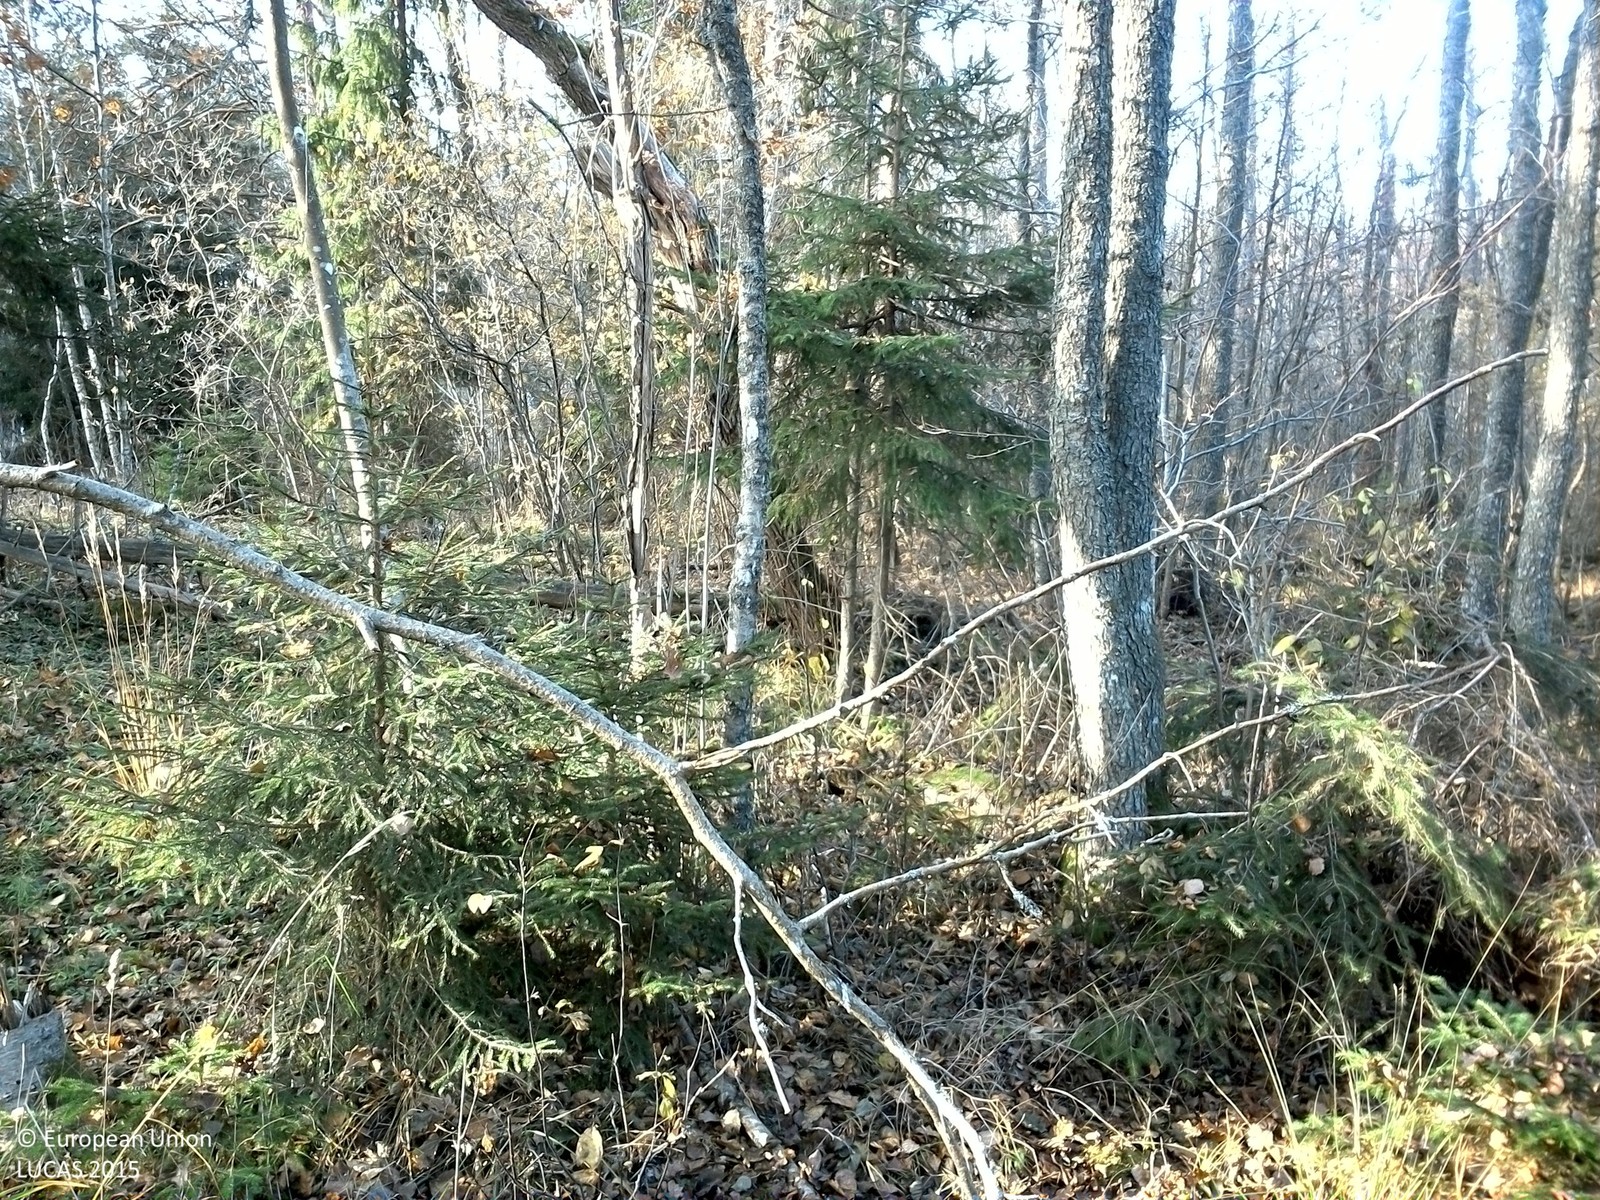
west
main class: Woodland
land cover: Broadleaved woodland
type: hemiboreal forest and nemoral coniferous forest and mixed broadleaved-coniferous forest
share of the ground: > 75 %
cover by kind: broadleaved forest trees 75 %, herbaceous plants 10 %, lichens and mosses 10 %, coniferous forest trees 5 %
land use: Forestry
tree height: > 5 m
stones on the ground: < 10 %
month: October
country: SE
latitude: 59.4091
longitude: 17.0234
